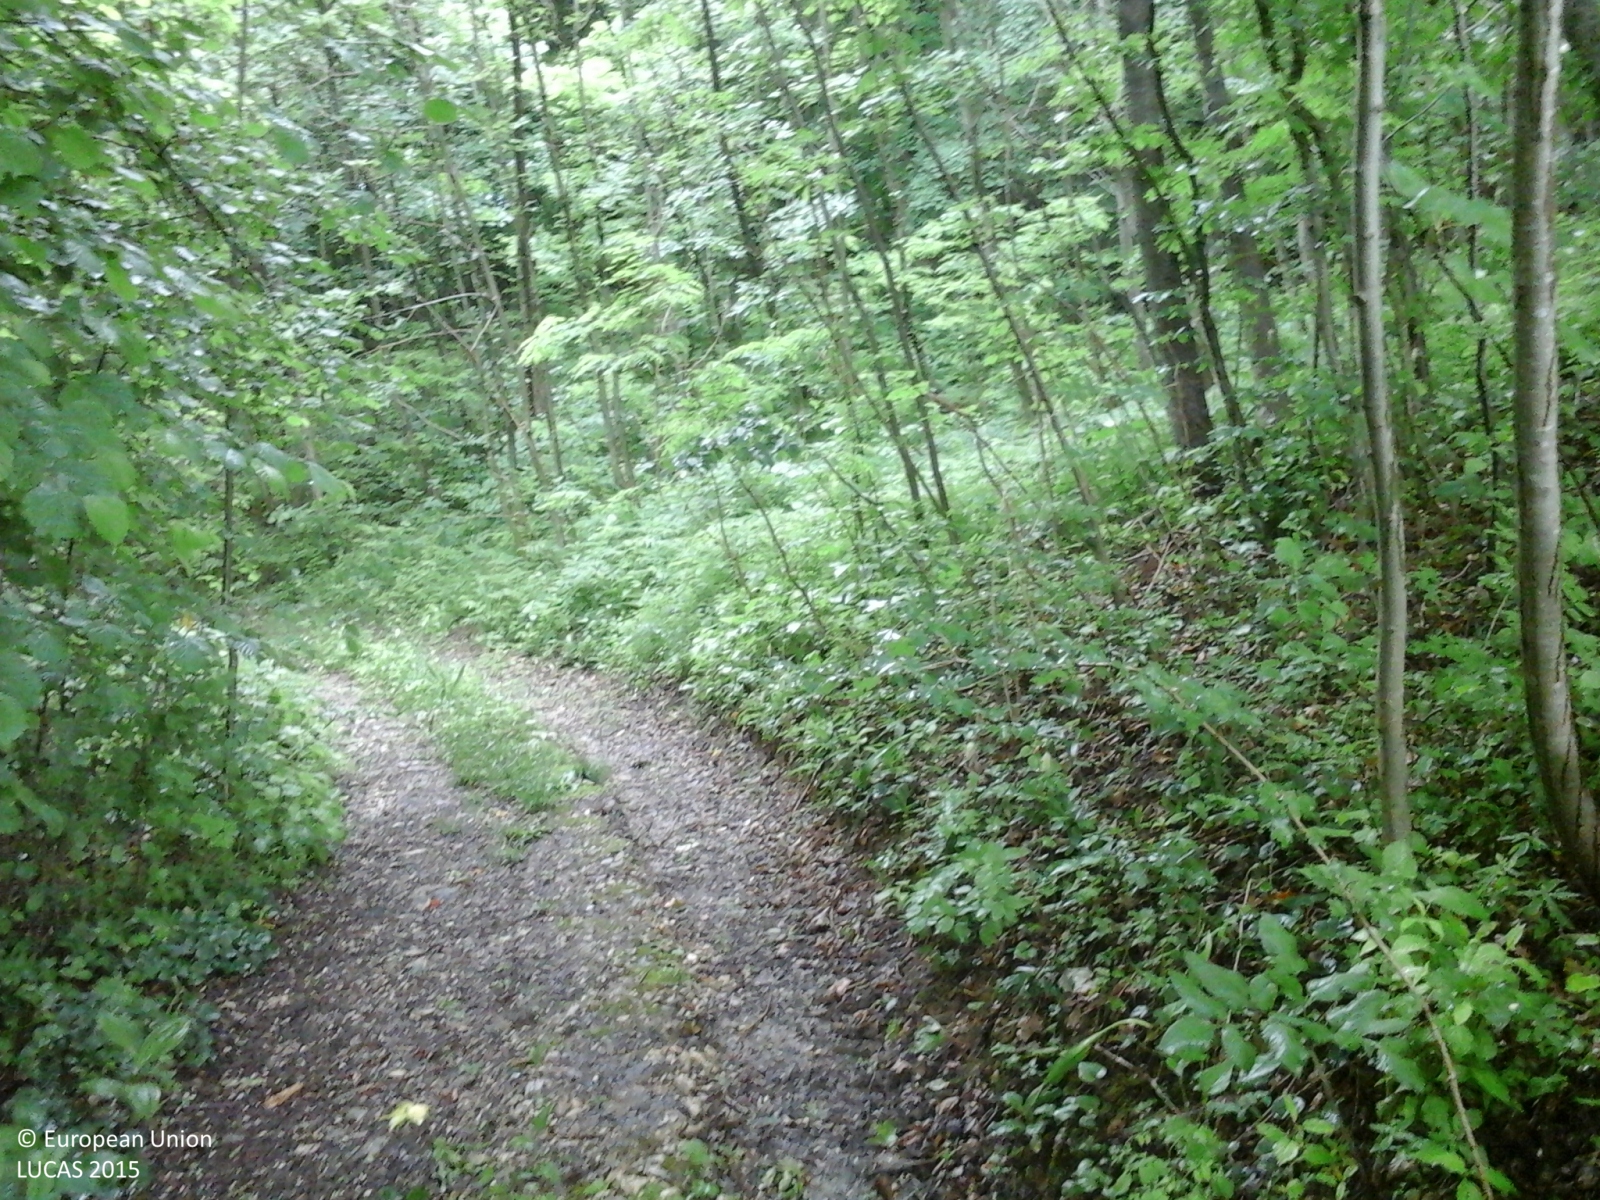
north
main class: Woodland
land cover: Broadleaved woodland
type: thermophilous deciduous forest
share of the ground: > 75 %
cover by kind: broadleaved forest trees 100 %
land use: Semi-natural and natural areas not in use
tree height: > 5 m
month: June
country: IT
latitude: 46.1268
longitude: 12.3654
